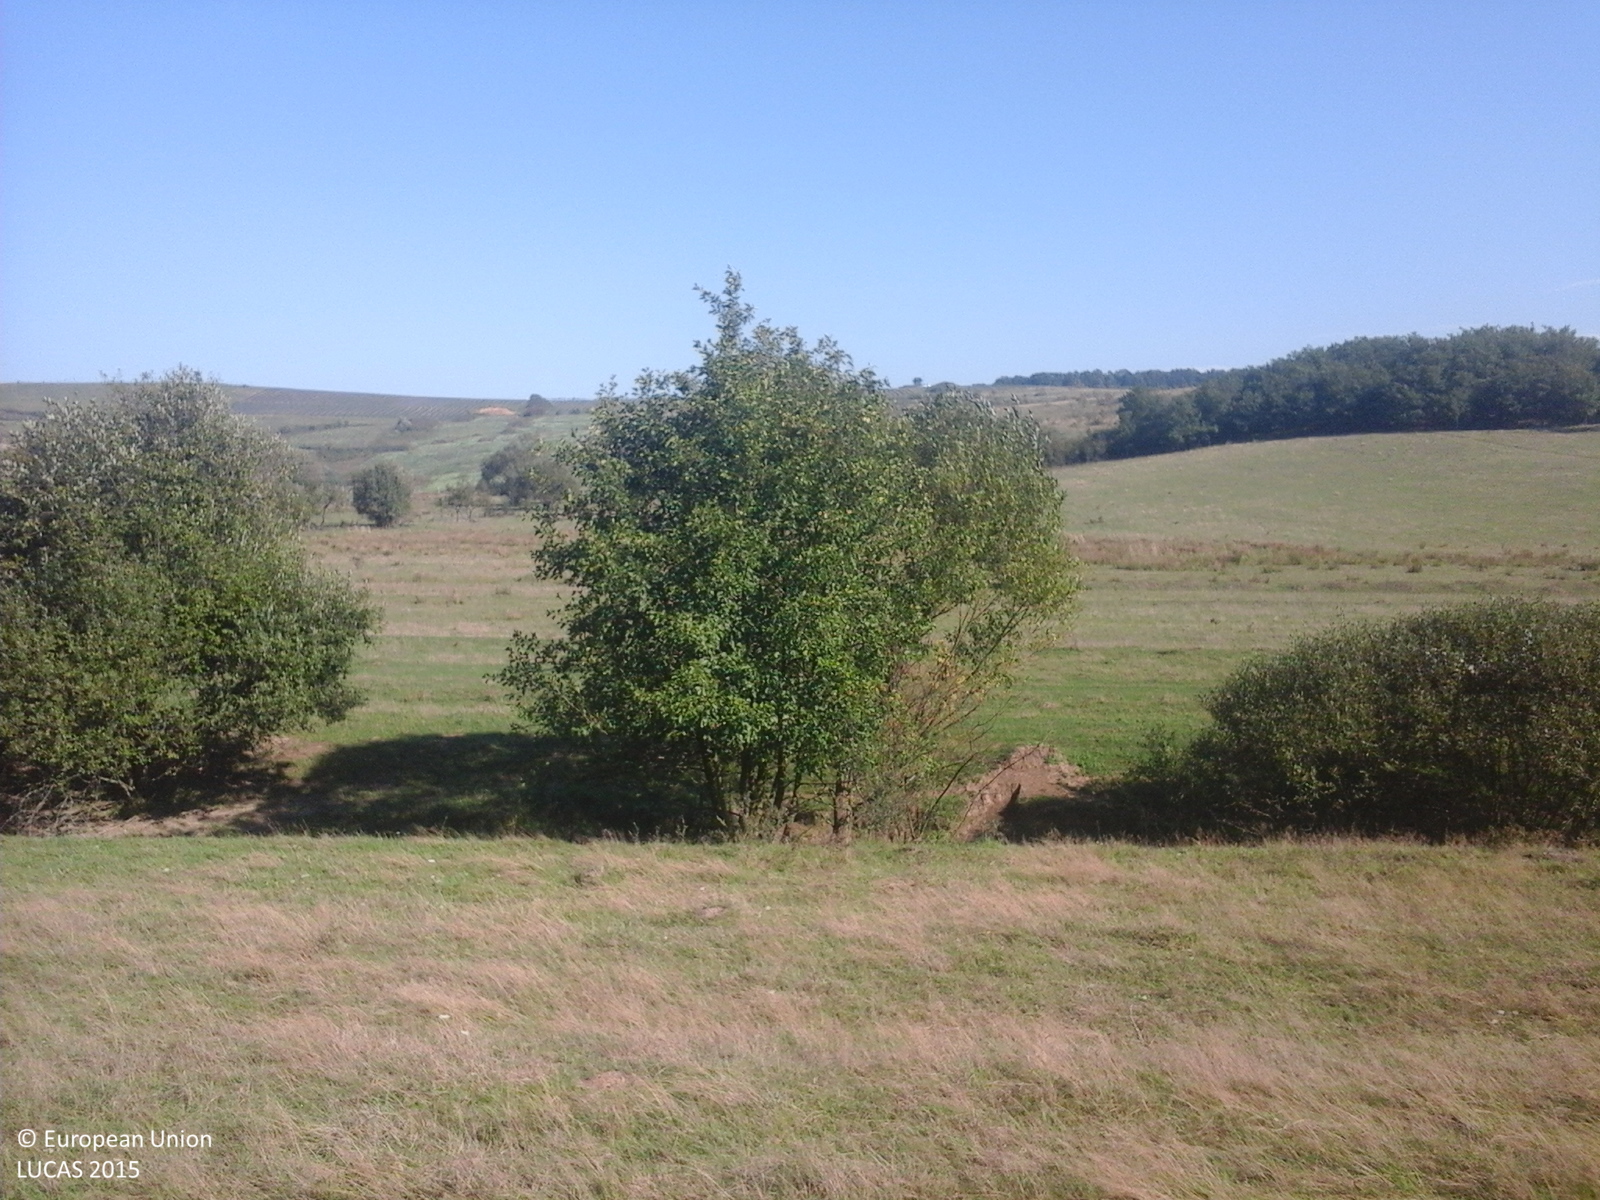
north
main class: Grassland
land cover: Grassland without tree/shrub cover
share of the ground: > 75 %
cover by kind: herbaceous plants 100 %
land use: Agriculture (excluding fallow land and kitchen gardens)
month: September
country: RO
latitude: 47.1683
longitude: 22.7638
